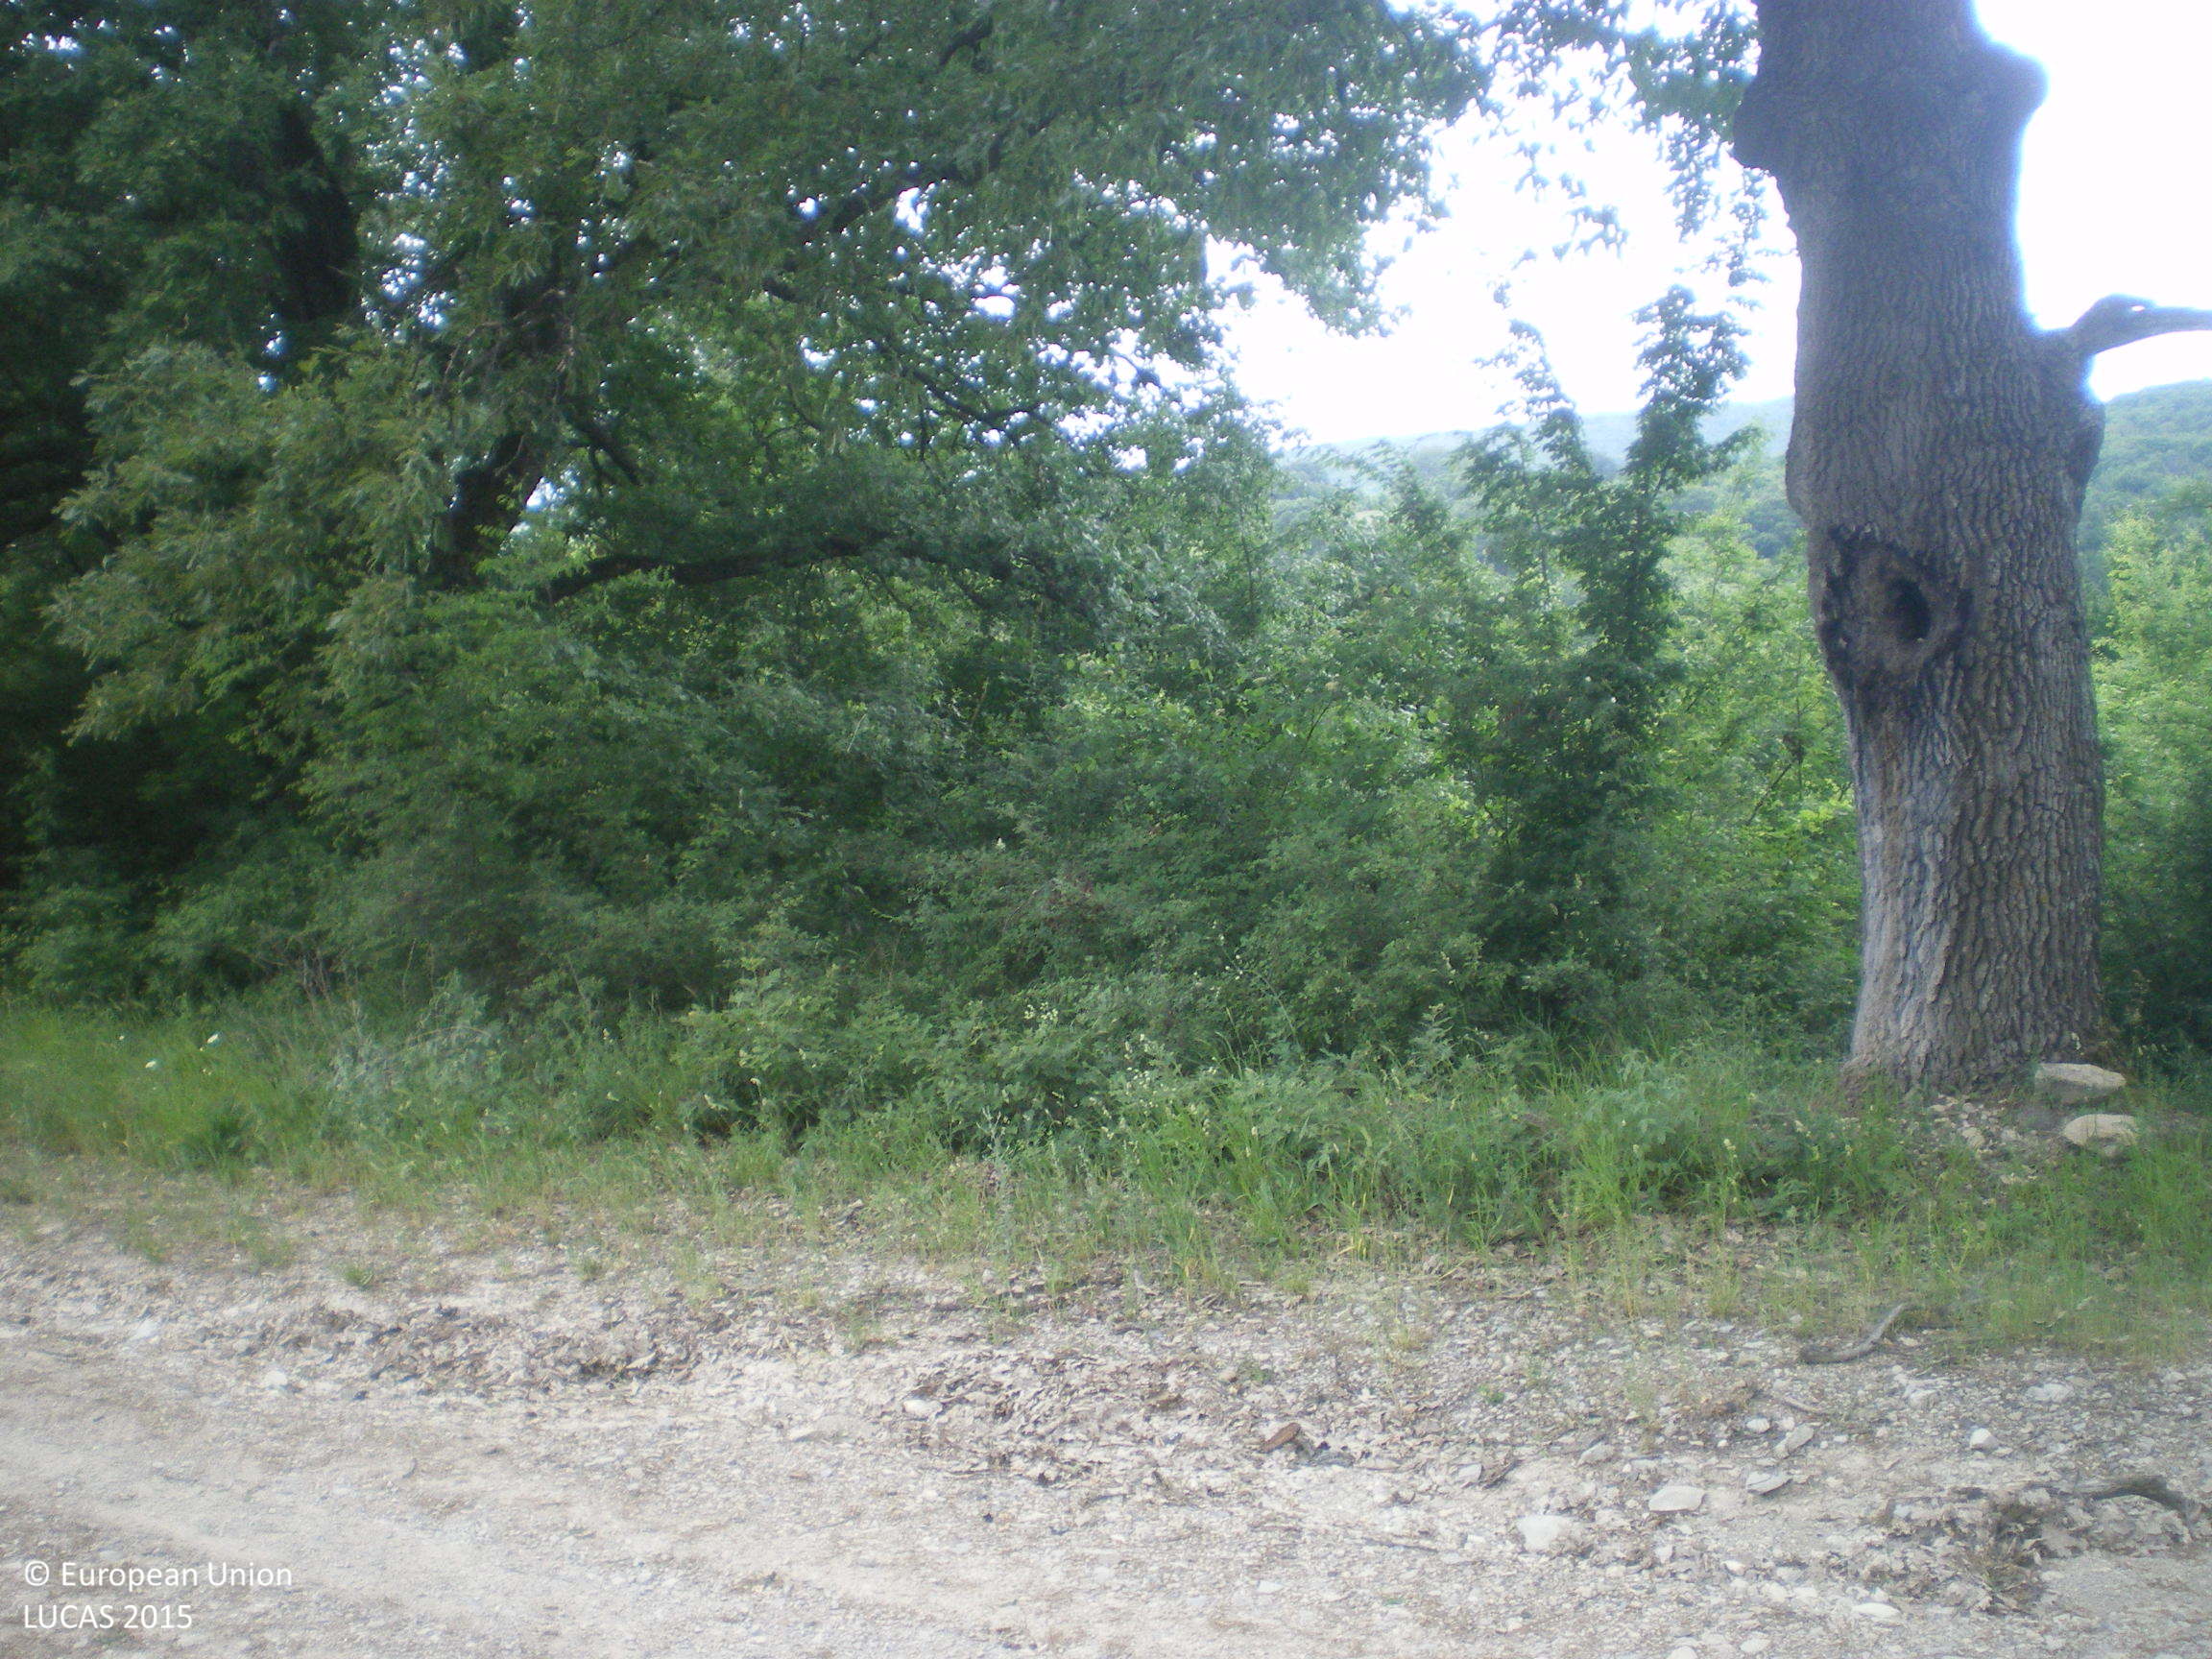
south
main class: Woodland
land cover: Broadleaved woodland
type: mesophytic deciduous forest
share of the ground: > 75 %
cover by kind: broadleaved forest trees 70 %, shrubs 20 %, herbaceous plants 10 %
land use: Forestry
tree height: > 5 m
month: May
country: BG
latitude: 42.2786
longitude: 25.3800
